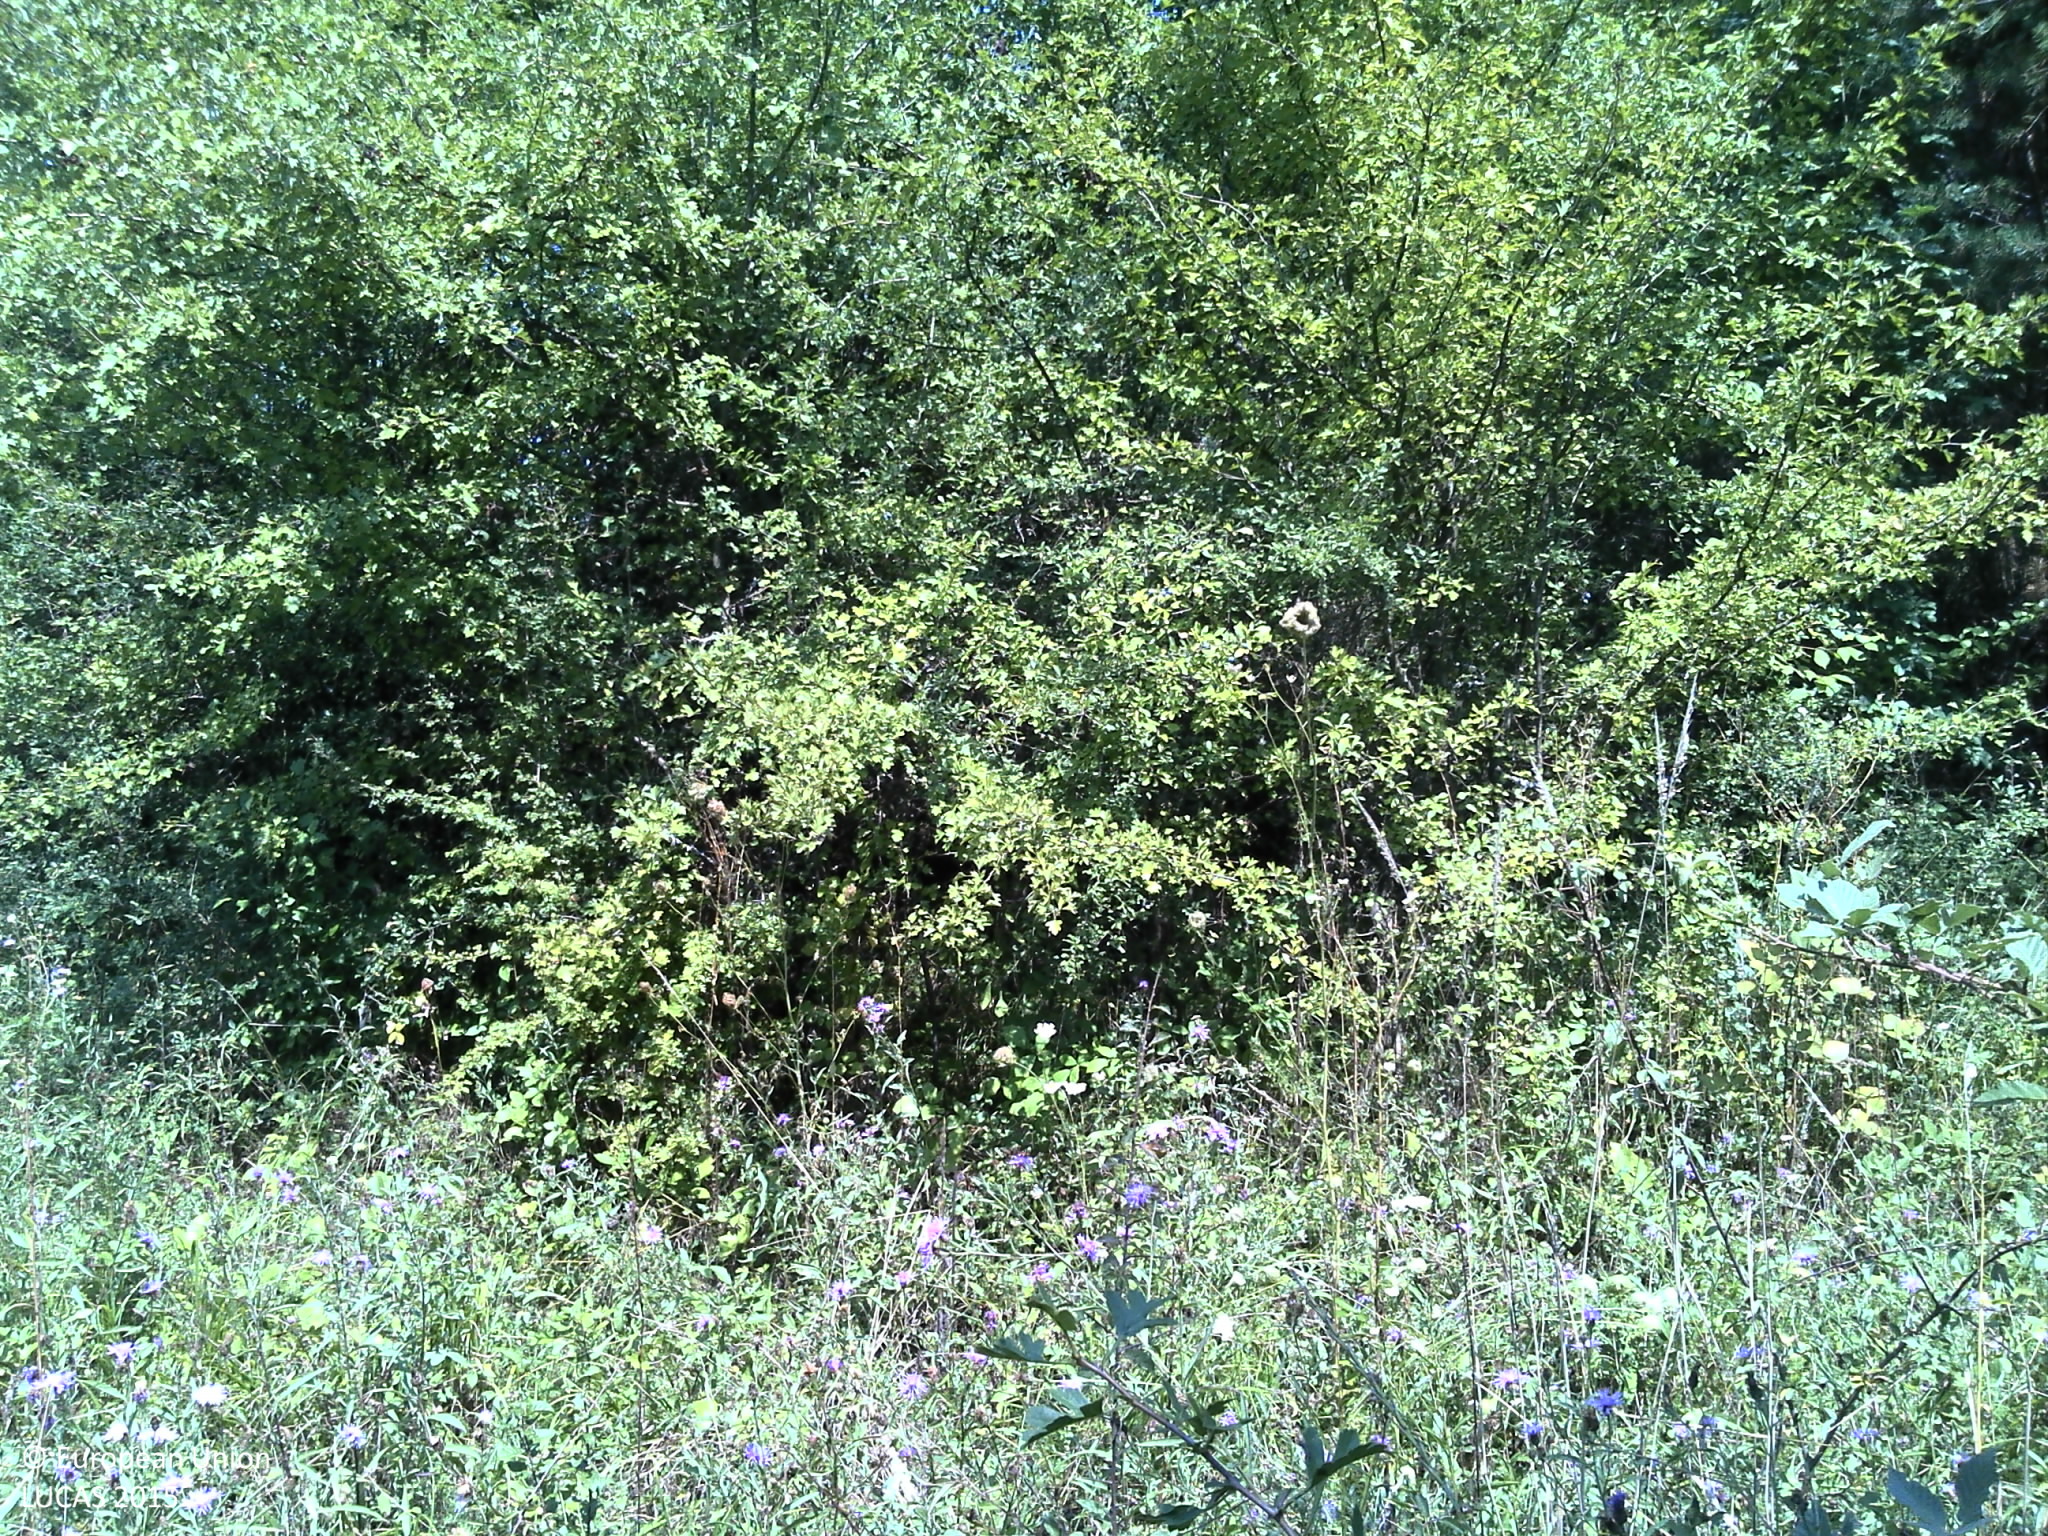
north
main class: Woodland
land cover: Broadleaved woodland
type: acidophilous oak and oak-birch forest
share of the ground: > 75 %
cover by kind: broadleaved forest trees 100 %
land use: Forestry
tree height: > 5 m
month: August
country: HR
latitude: 45.1465
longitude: 16.1137
